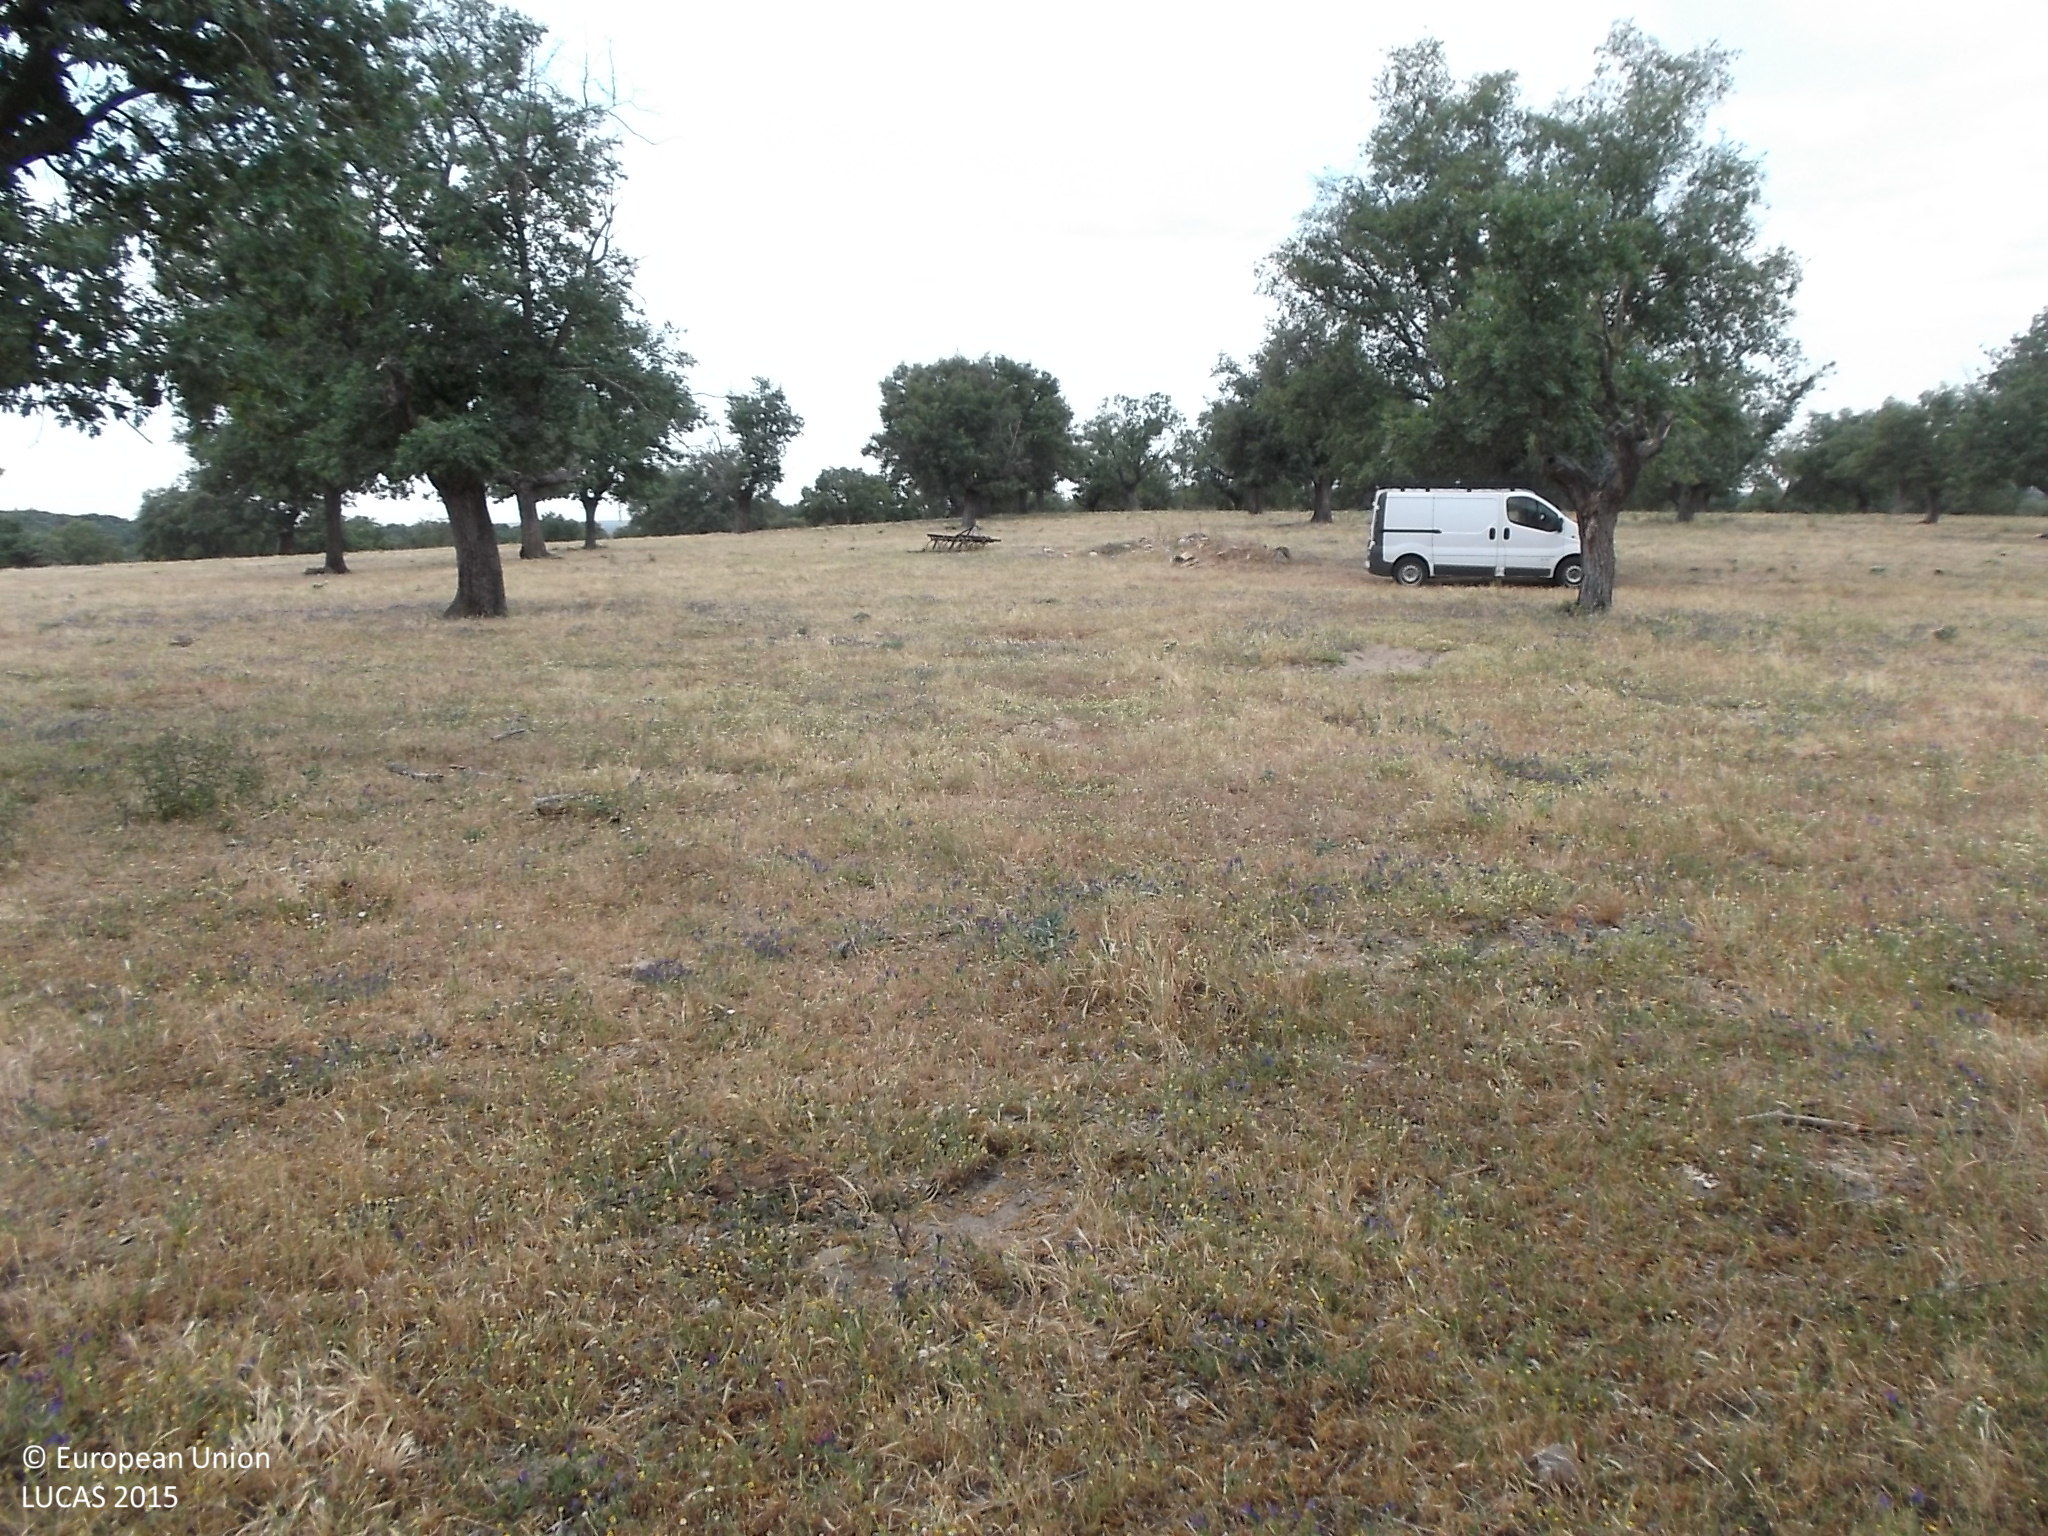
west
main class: Woodland
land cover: Broadleaved woodland
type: broadleaved evergreen forest
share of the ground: 25 - 50 %
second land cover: Grassland without tree/shrub cover
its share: > 75 %
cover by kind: herbaceous plants 80 %, broadleaved forest trees 20 %
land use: Forestry
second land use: Agriculture (excluding fallow land and kitchen gardens)
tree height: > 5 m
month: June
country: ES
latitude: 40.7664
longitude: -6.3299
